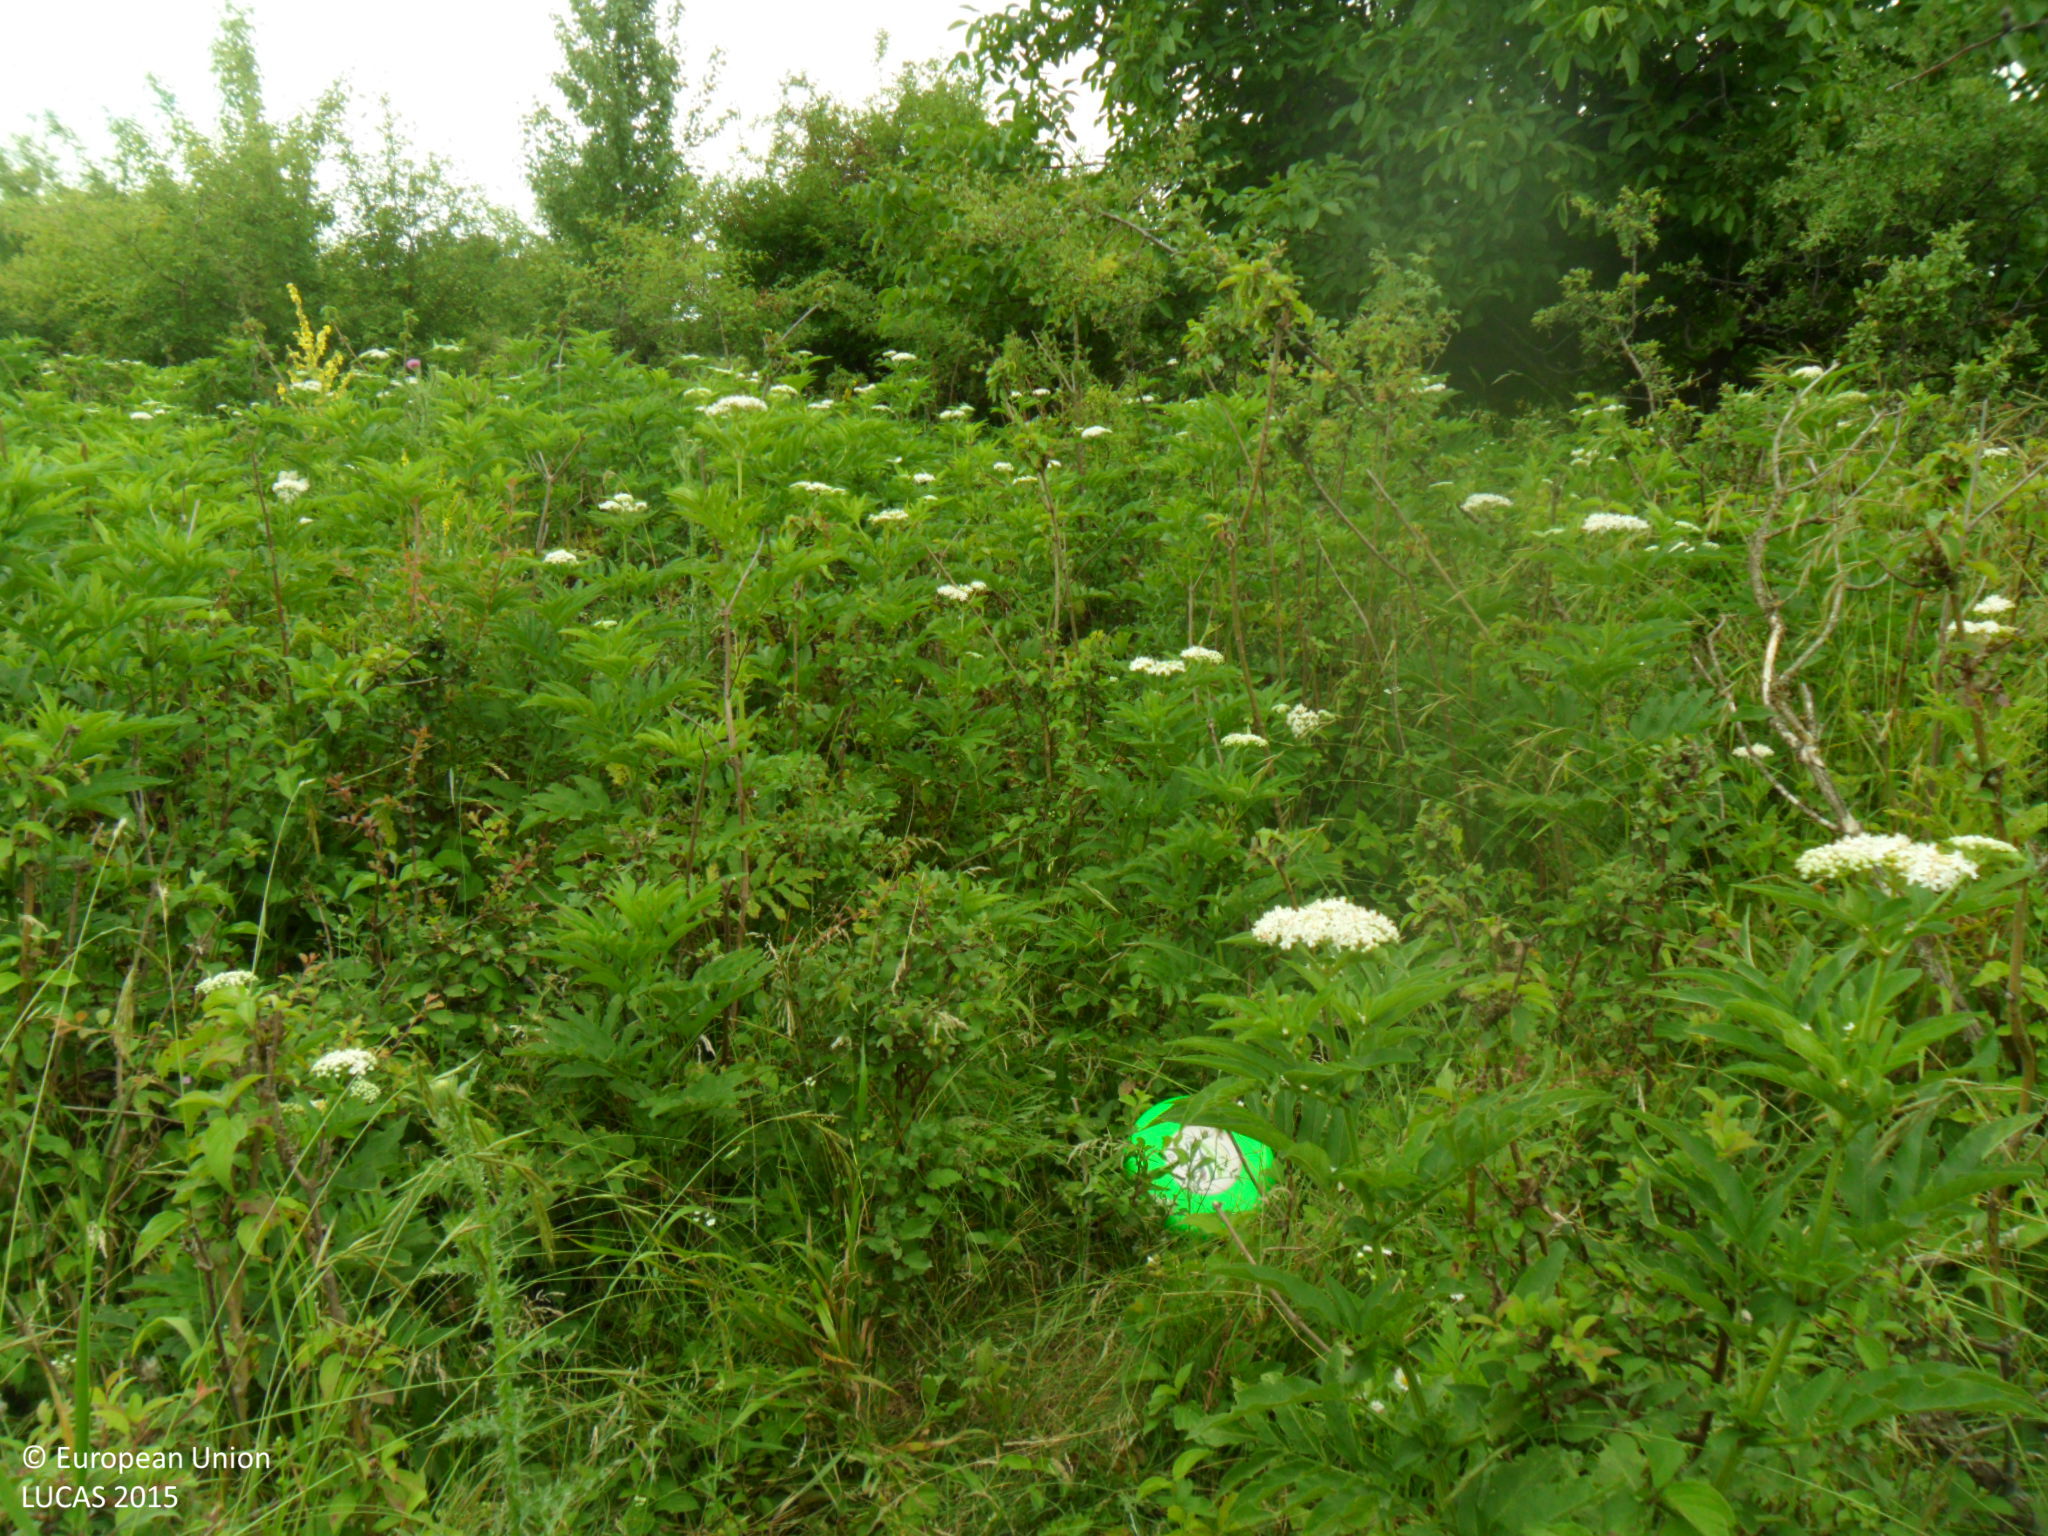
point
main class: Shrubland
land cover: Shrubland with sparse tree cover
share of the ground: > 75 %
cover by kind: herbaceous plants 60 %, shrubs 35 %, broadleaved forest trees 5 %
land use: Agriculture (excluding fallow land and kitchen gardens)
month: June
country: BG
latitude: 43.4567
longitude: 26.6309
